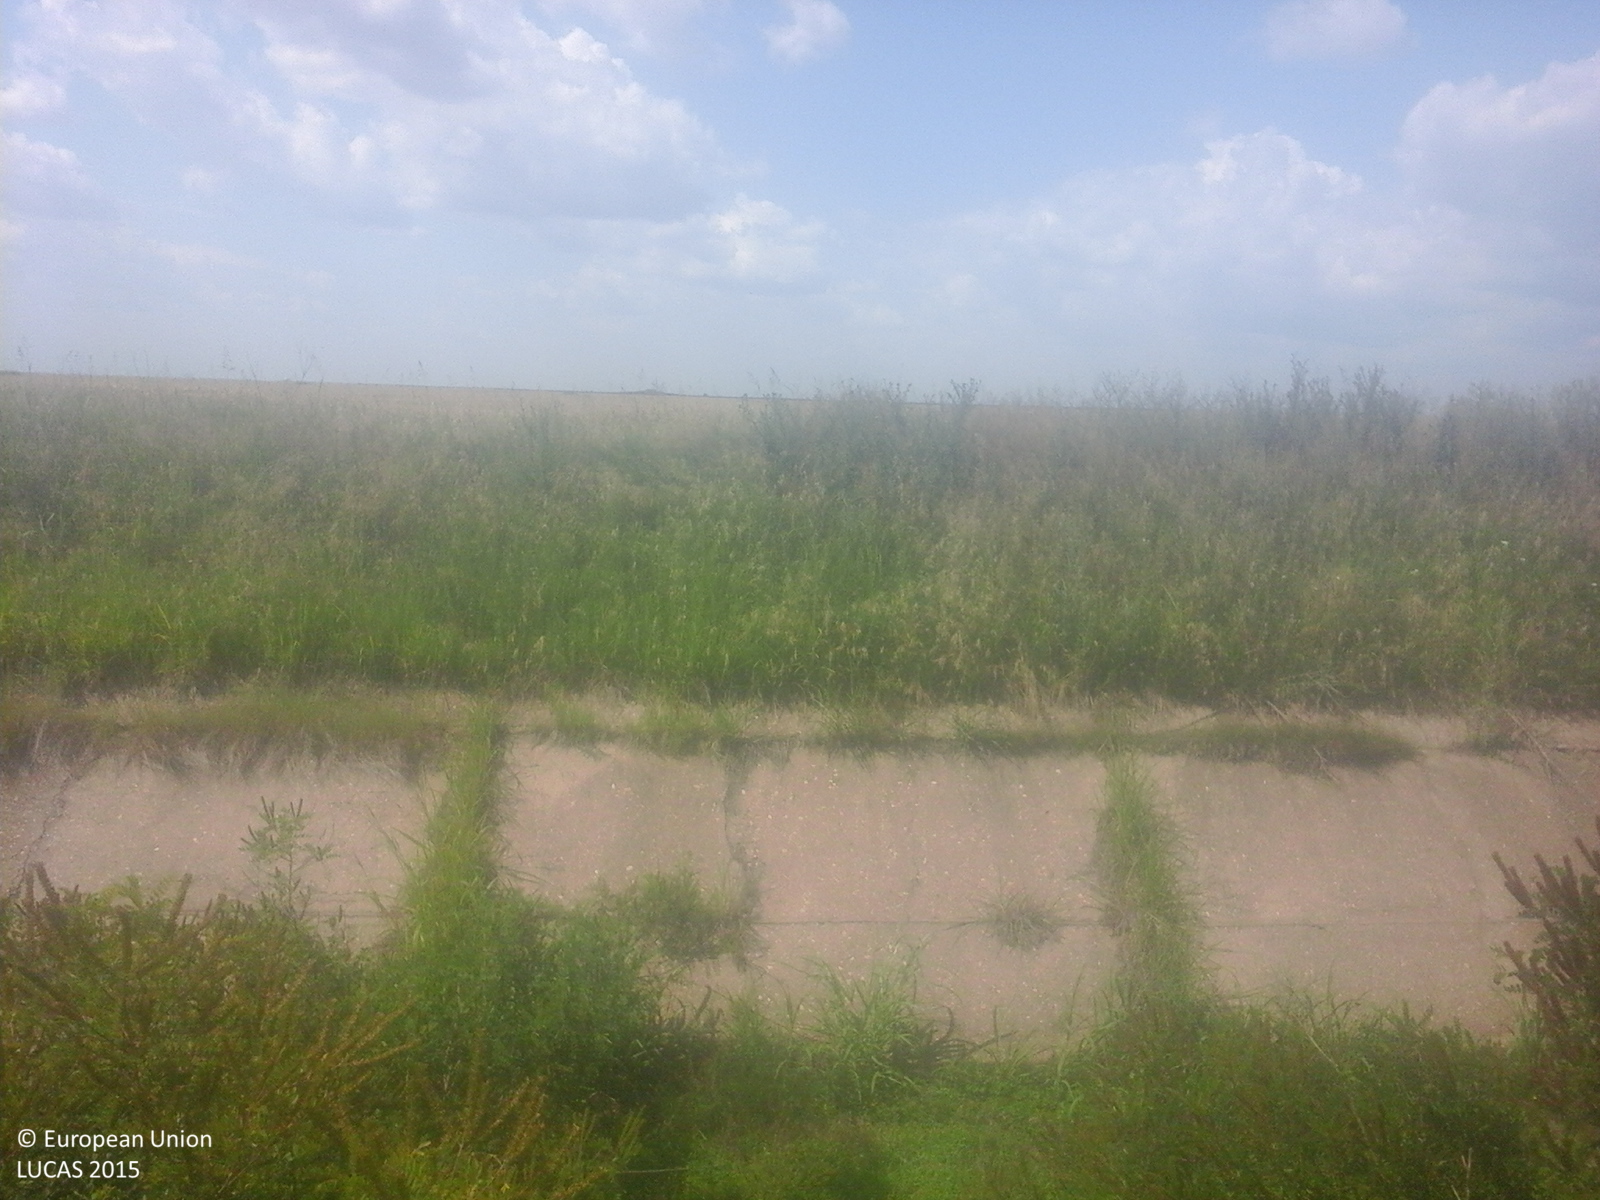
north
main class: Grassland
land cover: Spontaneously vegetated surfaces
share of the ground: > 75 %
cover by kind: herbaceous plants 100 %
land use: Fallow land
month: July
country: RO
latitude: 43.8130
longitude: 24.5488
